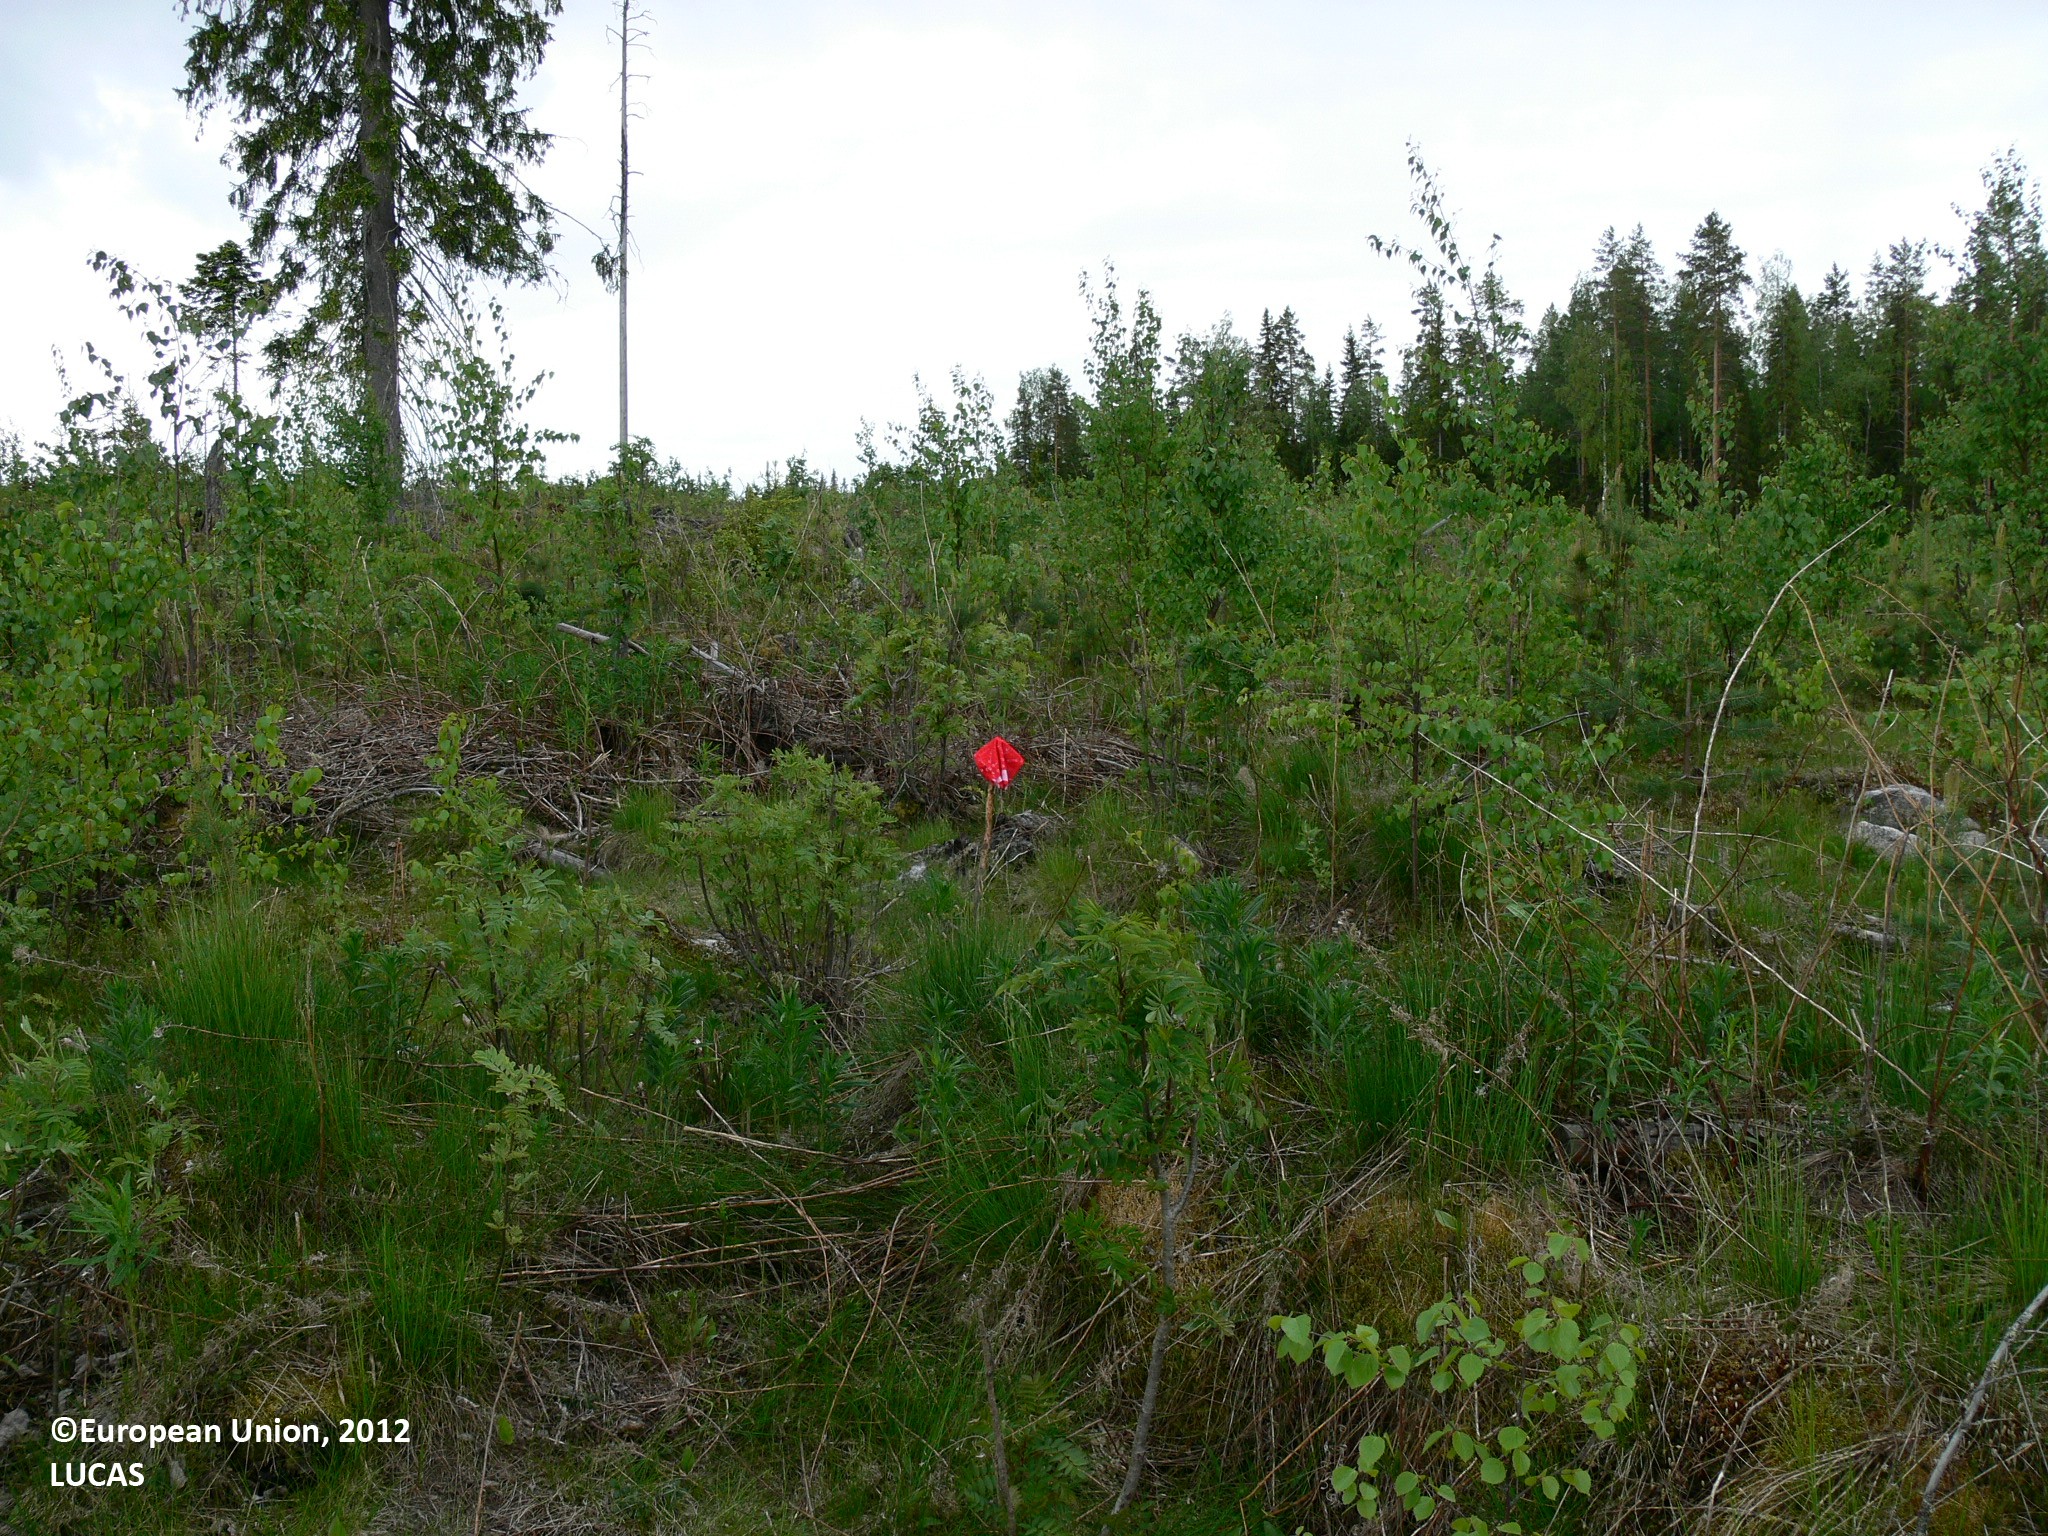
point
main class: Woodland
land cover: Other mixed woodland
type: boreal forest
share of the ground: 25 - 50 %
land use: Forestry
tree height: < 5 m
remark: Clear cut
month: June
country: FI
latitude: 62.6415
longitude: 30.3444
